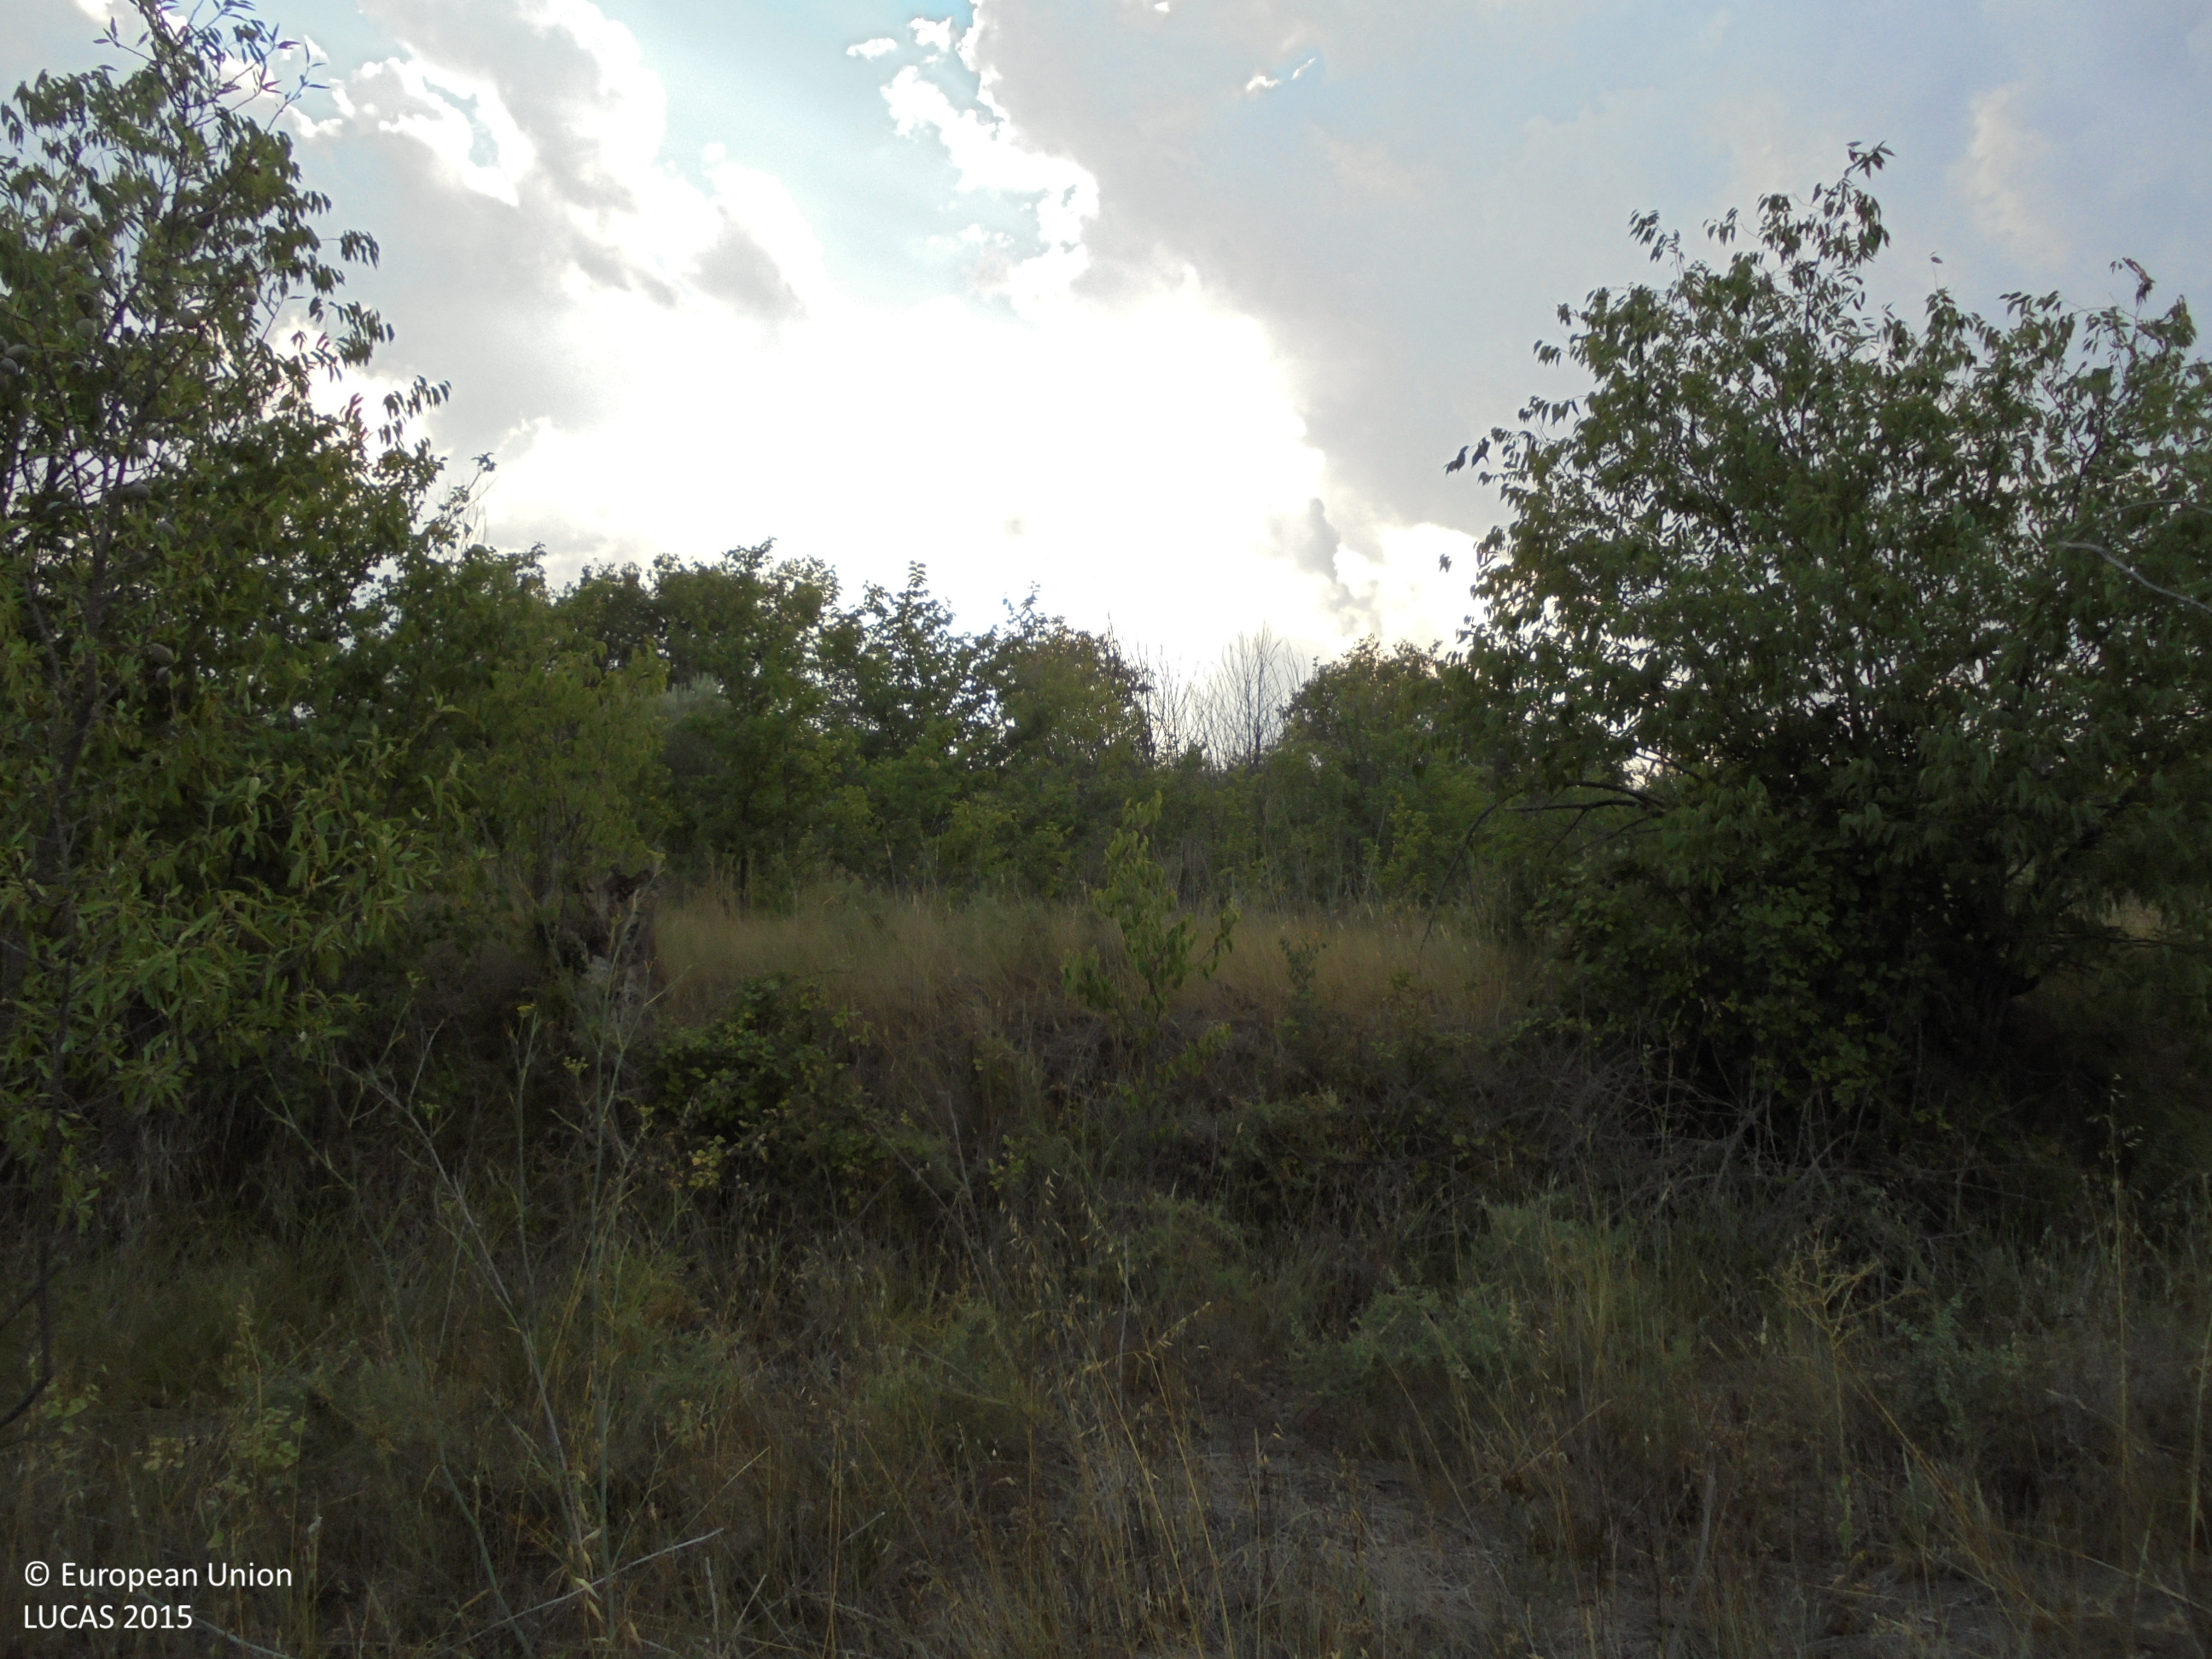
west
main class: Grassland
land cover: Grassland with sparse tree/shrub cover
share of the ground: > 75 %
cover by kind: herbaceous plants 95 %, broadleaved forest trees 5 %
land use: Abandoned areas
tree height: < 5 m
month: July
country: ES
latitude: 39.0949
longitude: -1.0383
